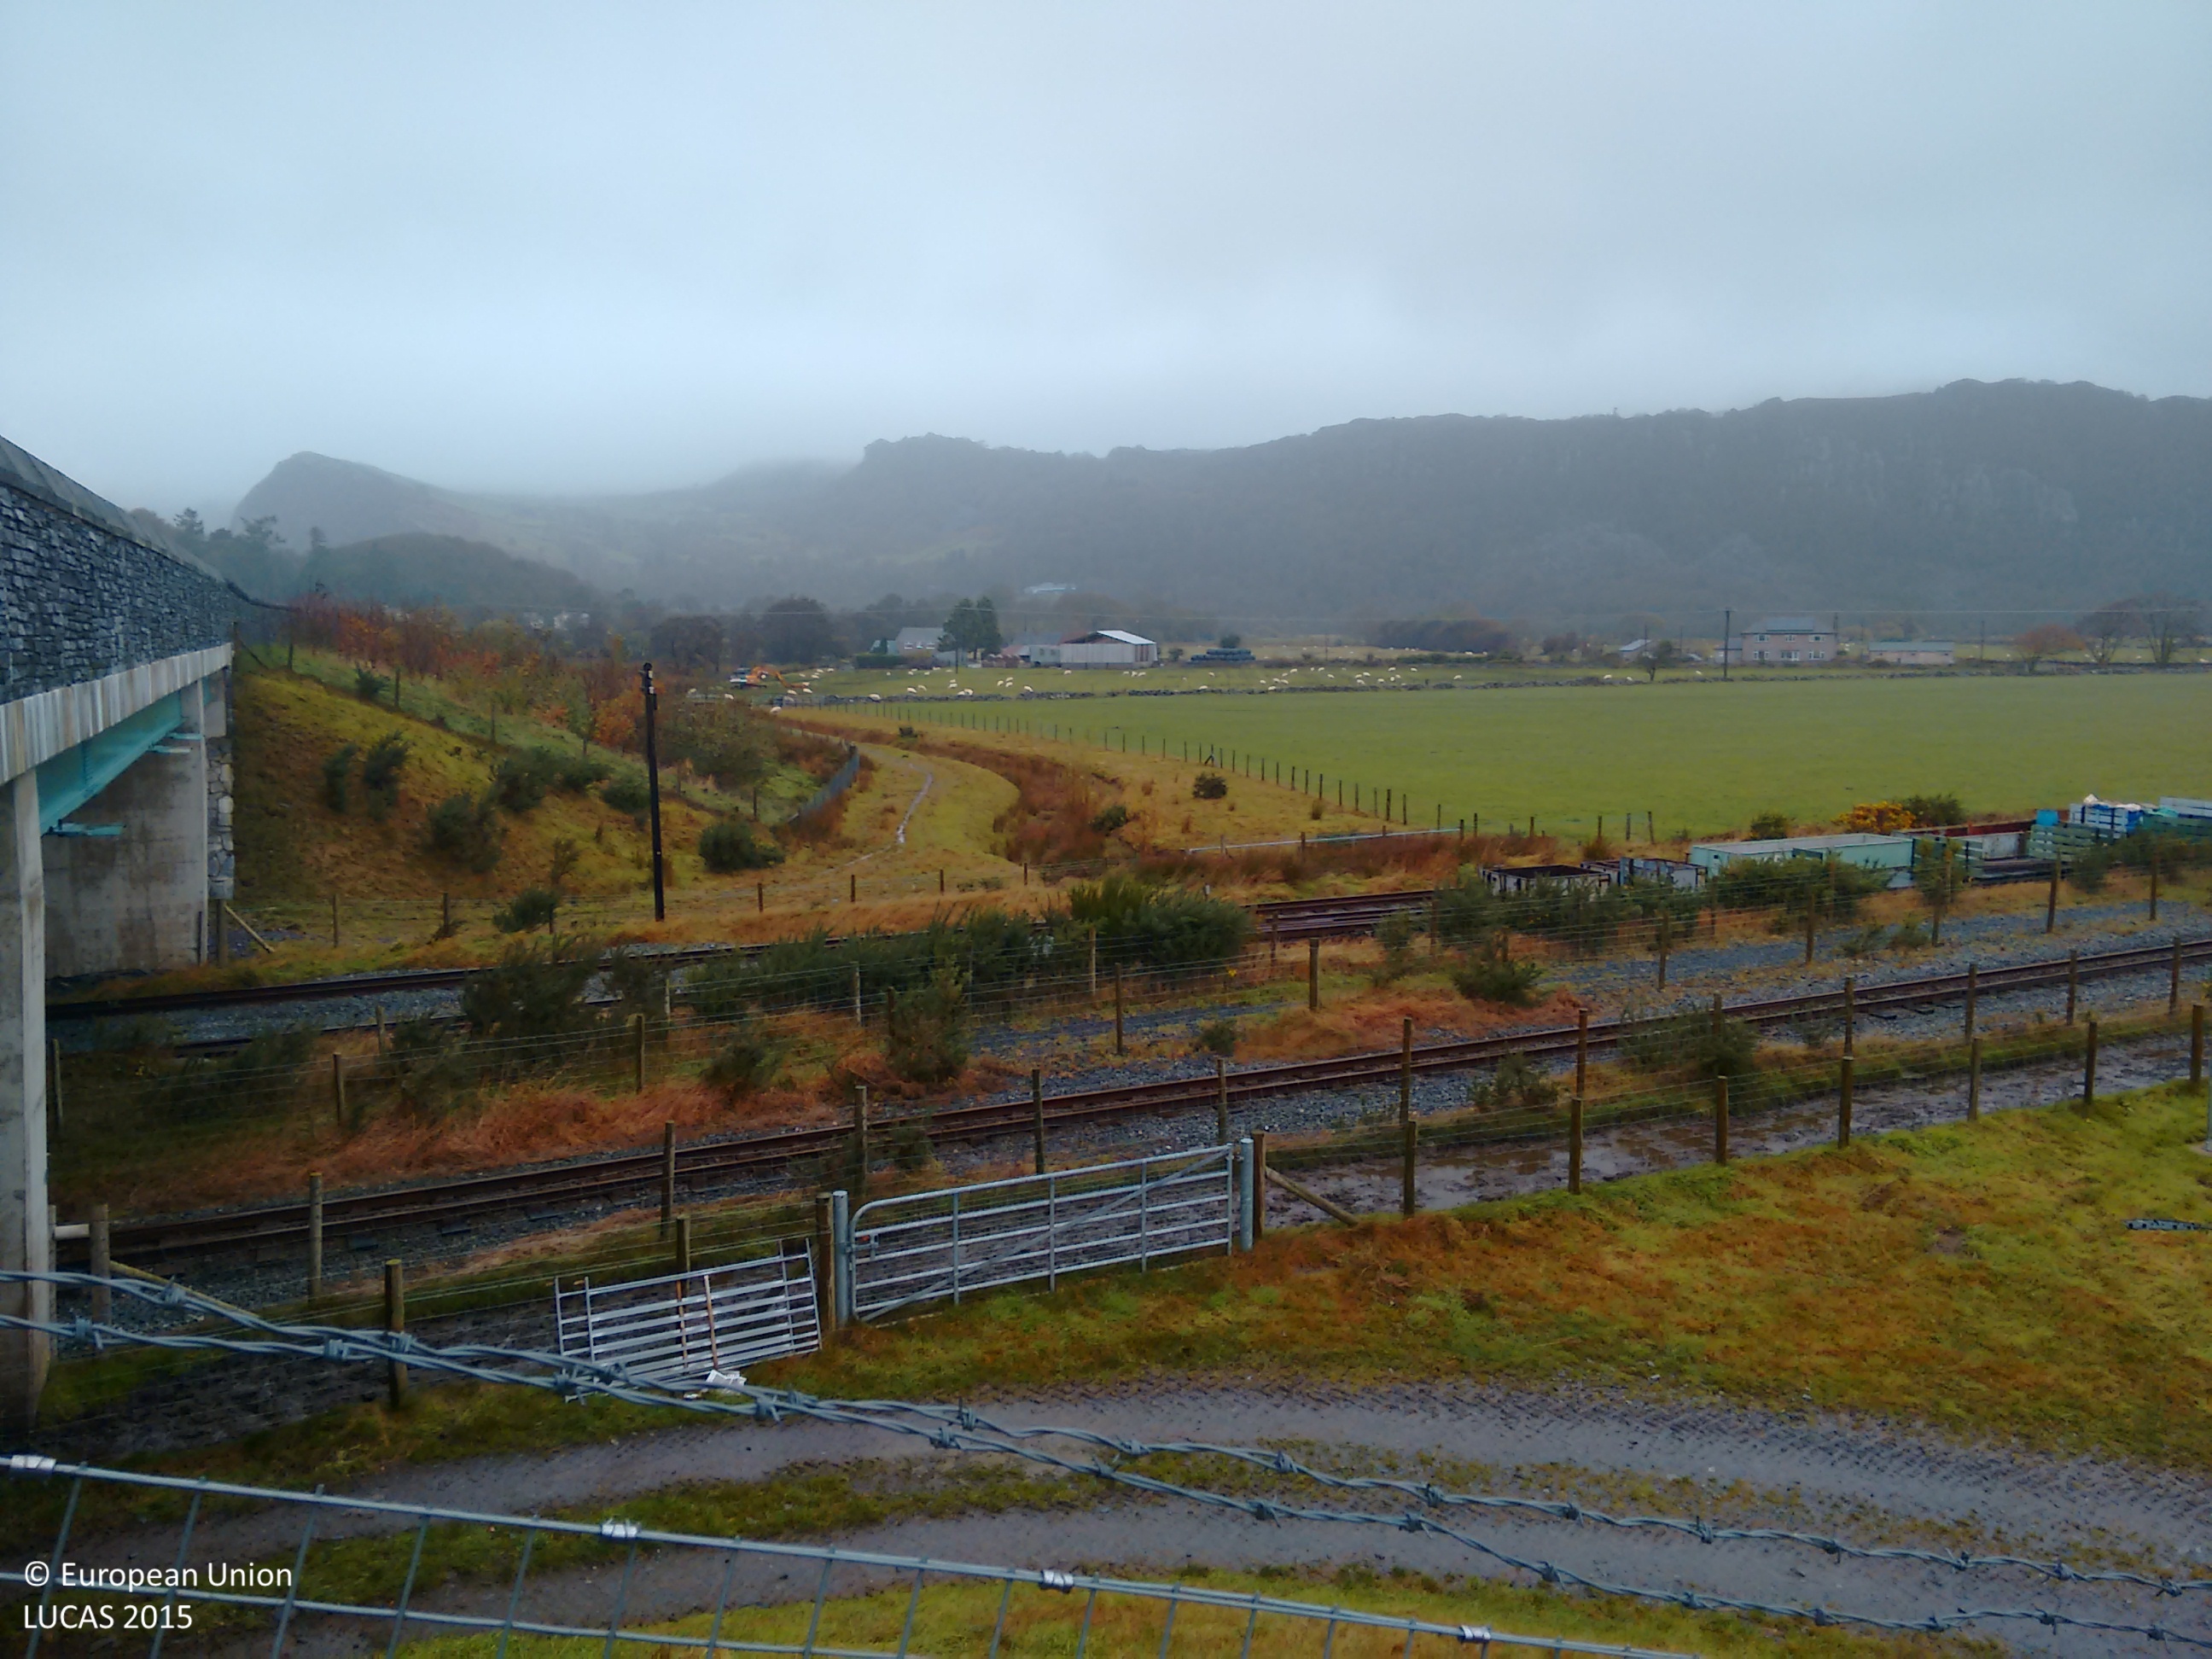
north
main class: Grassland
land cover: Grassland without tree/shrub cover
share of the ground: > 75 %
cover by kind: herbaceous plants 100 %
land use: Agriculture (excluding fallow land and kitchen gardens)
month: November
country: GB
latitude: 52.9334
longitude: -4.1267
